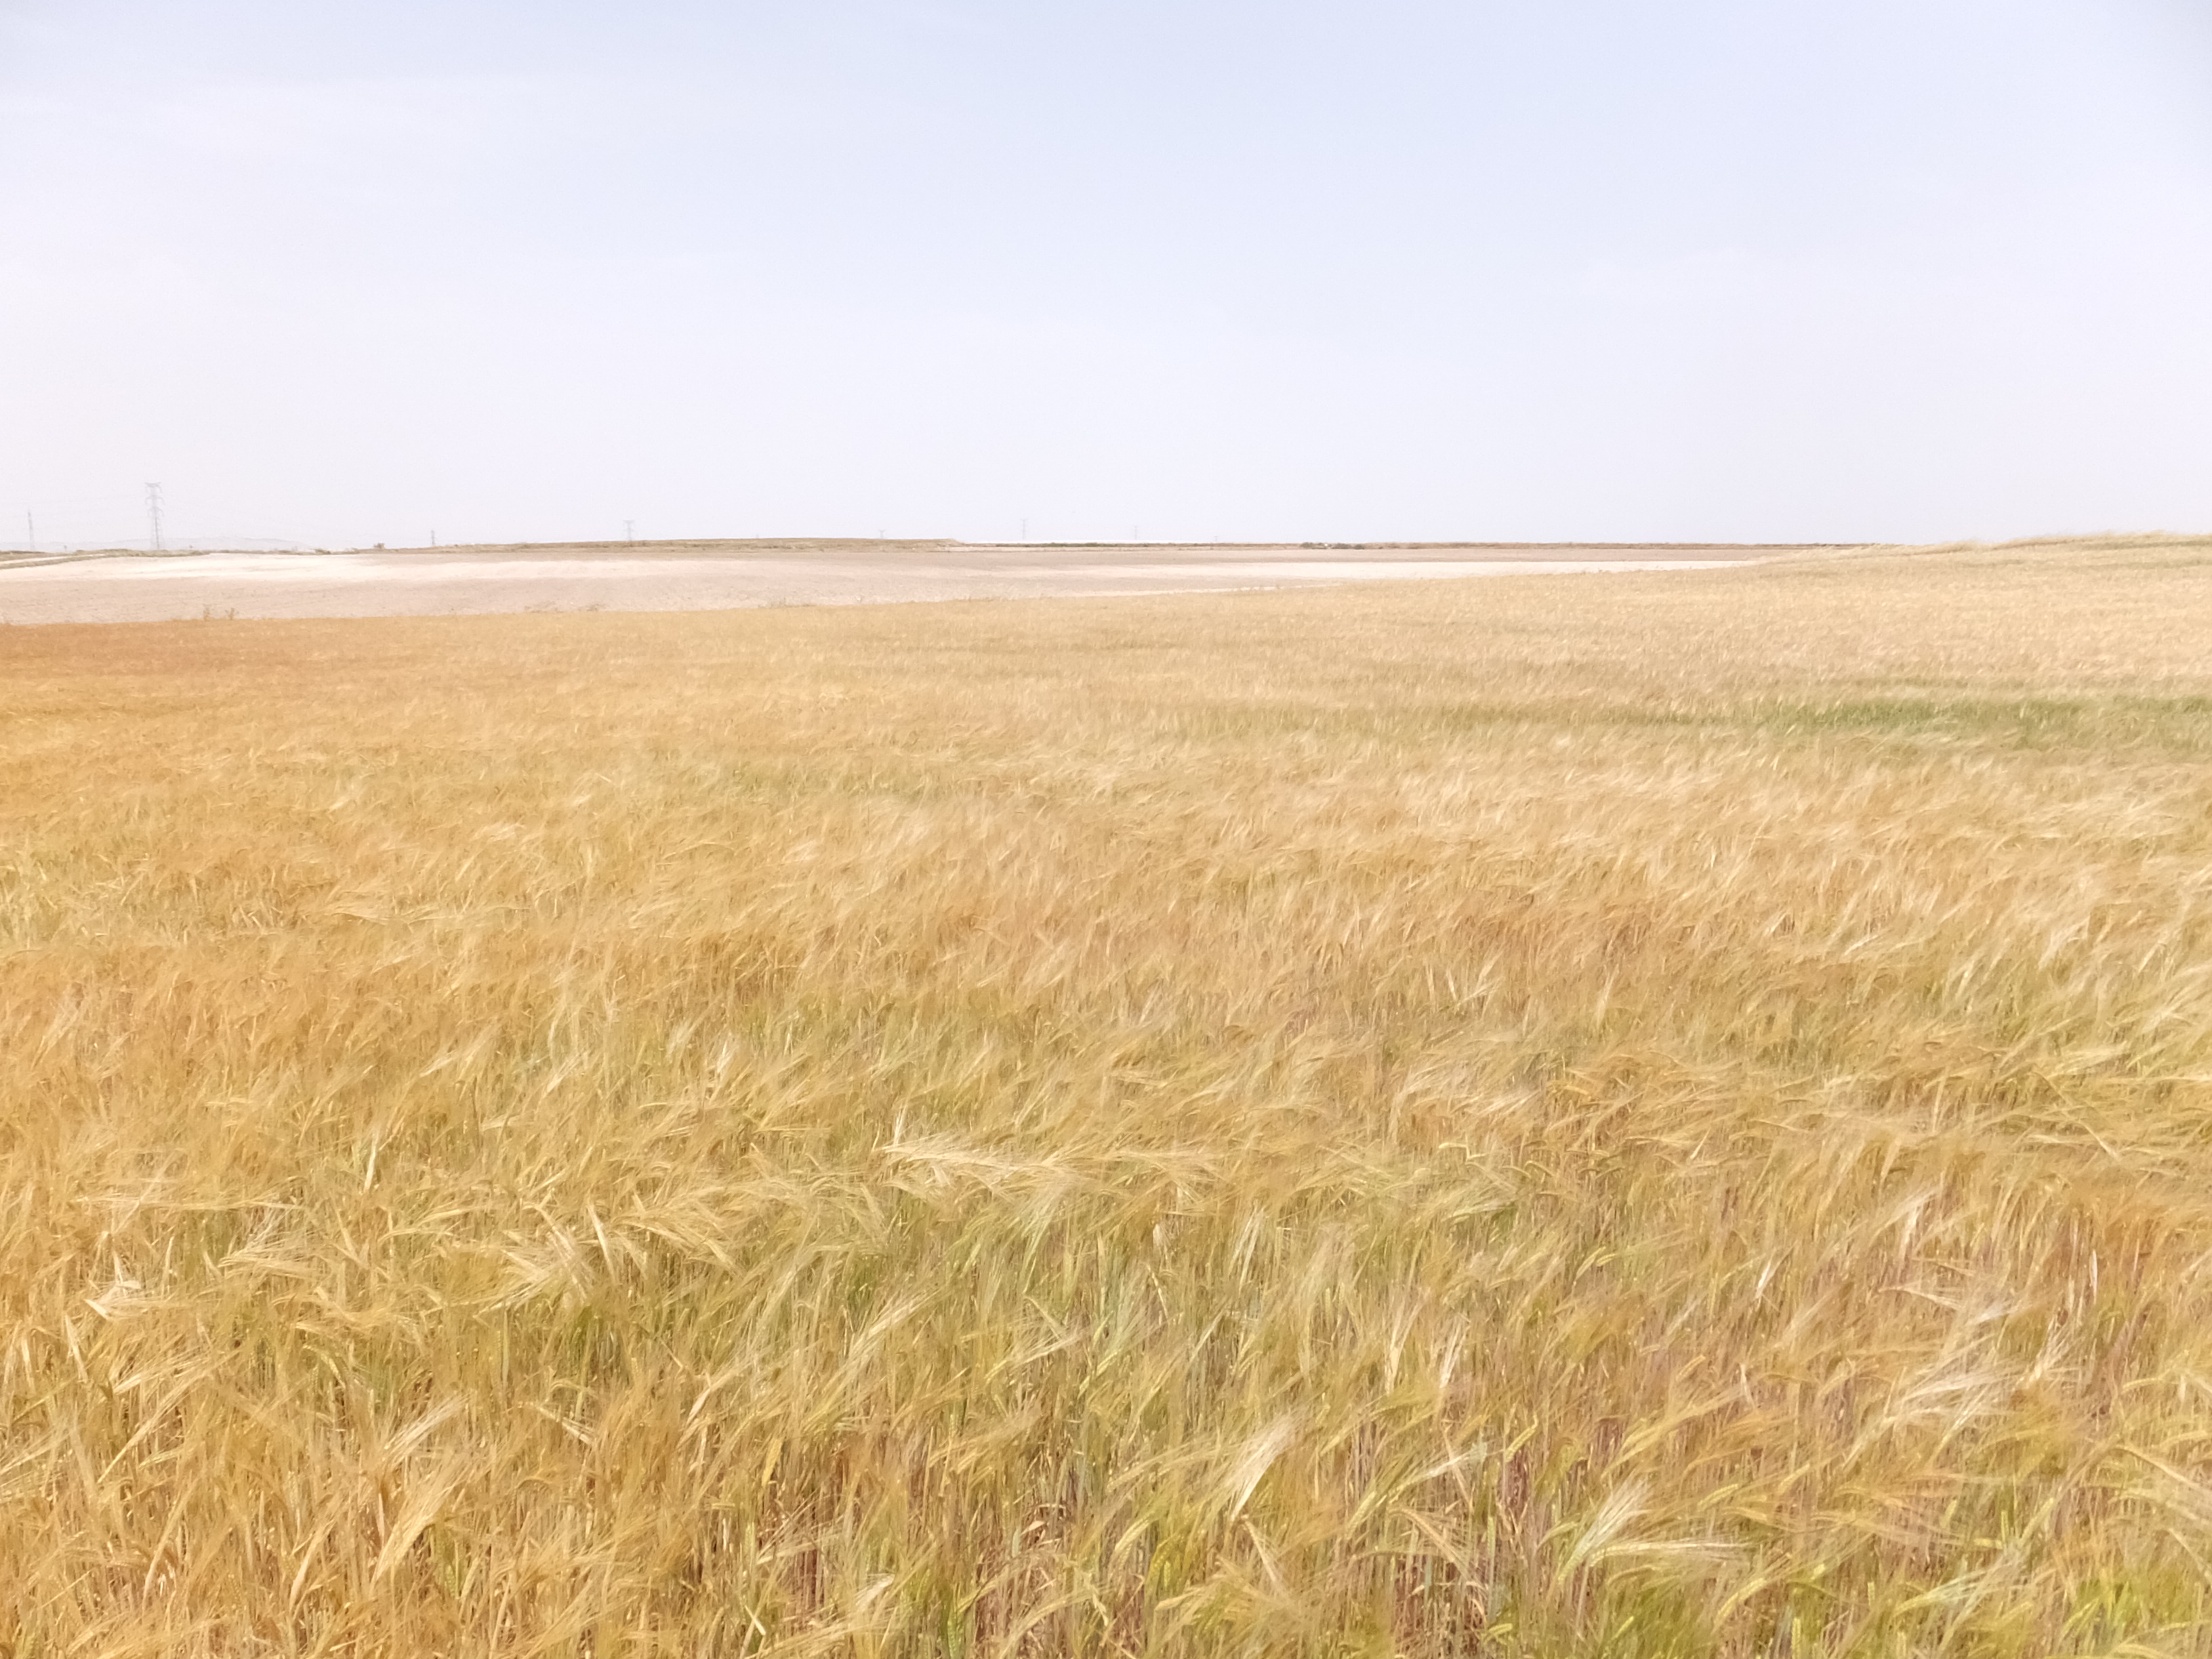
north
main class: Cropland
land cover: Barley
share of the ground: > 75 %
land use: Agriculture (excluding fallow land and kitchen gardens)
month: May
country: ES
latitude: 41.4177
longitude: -0.1245
